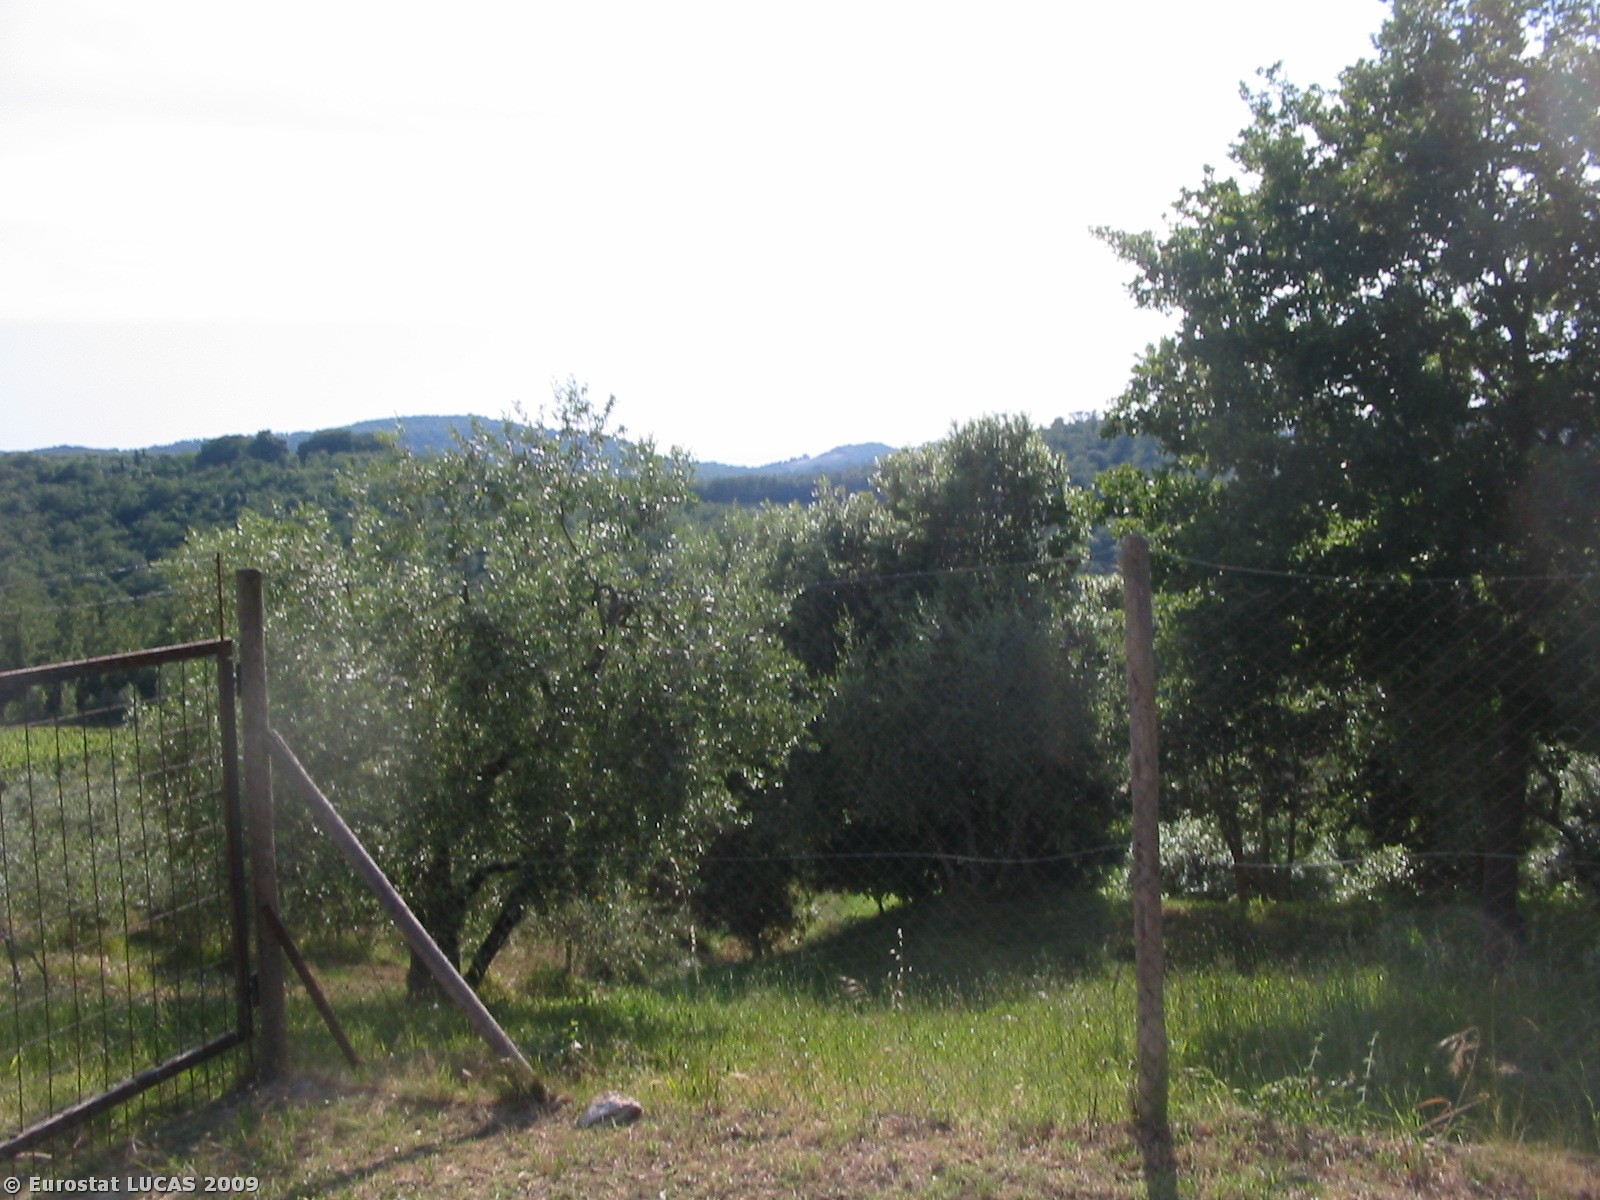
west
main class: Woodland
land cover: Broadleaved woodland
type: mesophytic deciduous forest
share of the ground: > 75 %
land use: Forestry
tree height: > 5 m
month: July
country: IT
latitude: 43.2364
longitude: 11.6576
